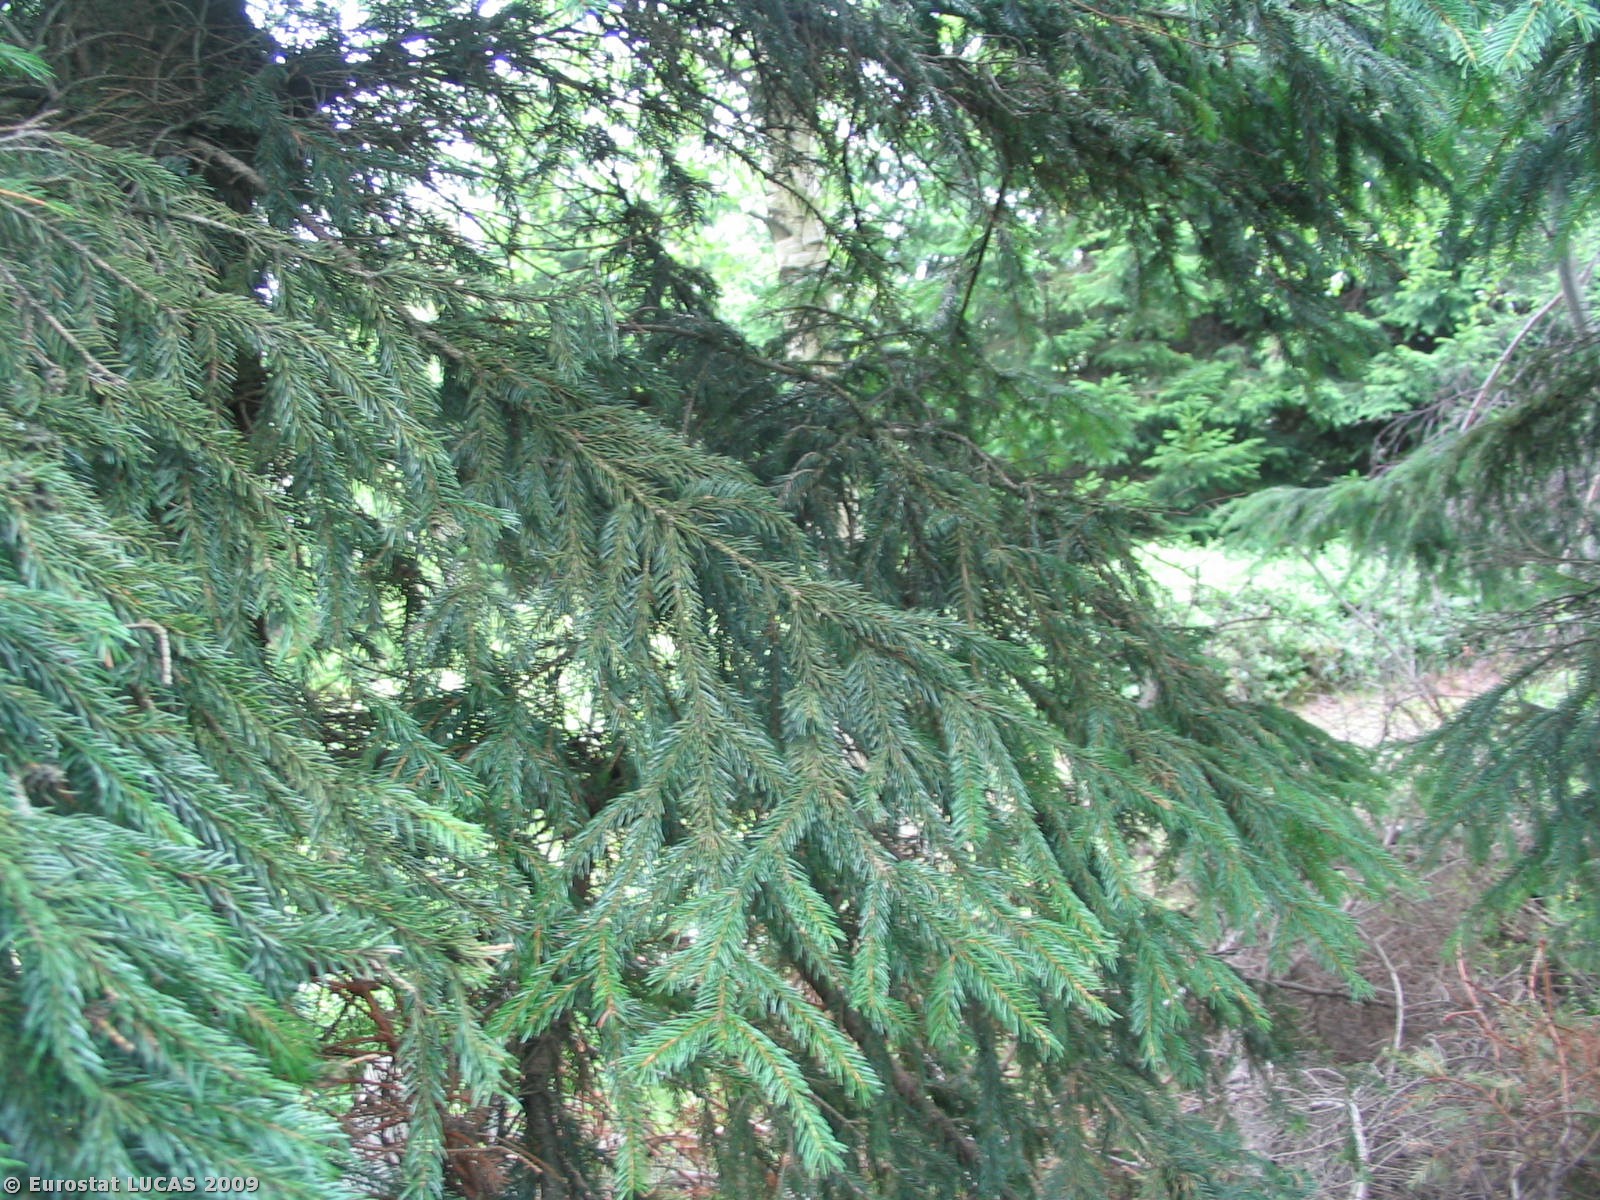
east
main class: Woodland
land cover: Mixed woodland
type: mountainous beech forest
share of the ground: > 75 %
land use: Forestry
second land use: Nature reserves
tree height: > 5 m
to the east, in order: Mixed woodland; Tracks; Mixed woodland
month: July
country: CZ
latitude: 50.7010
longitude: 15.8529
